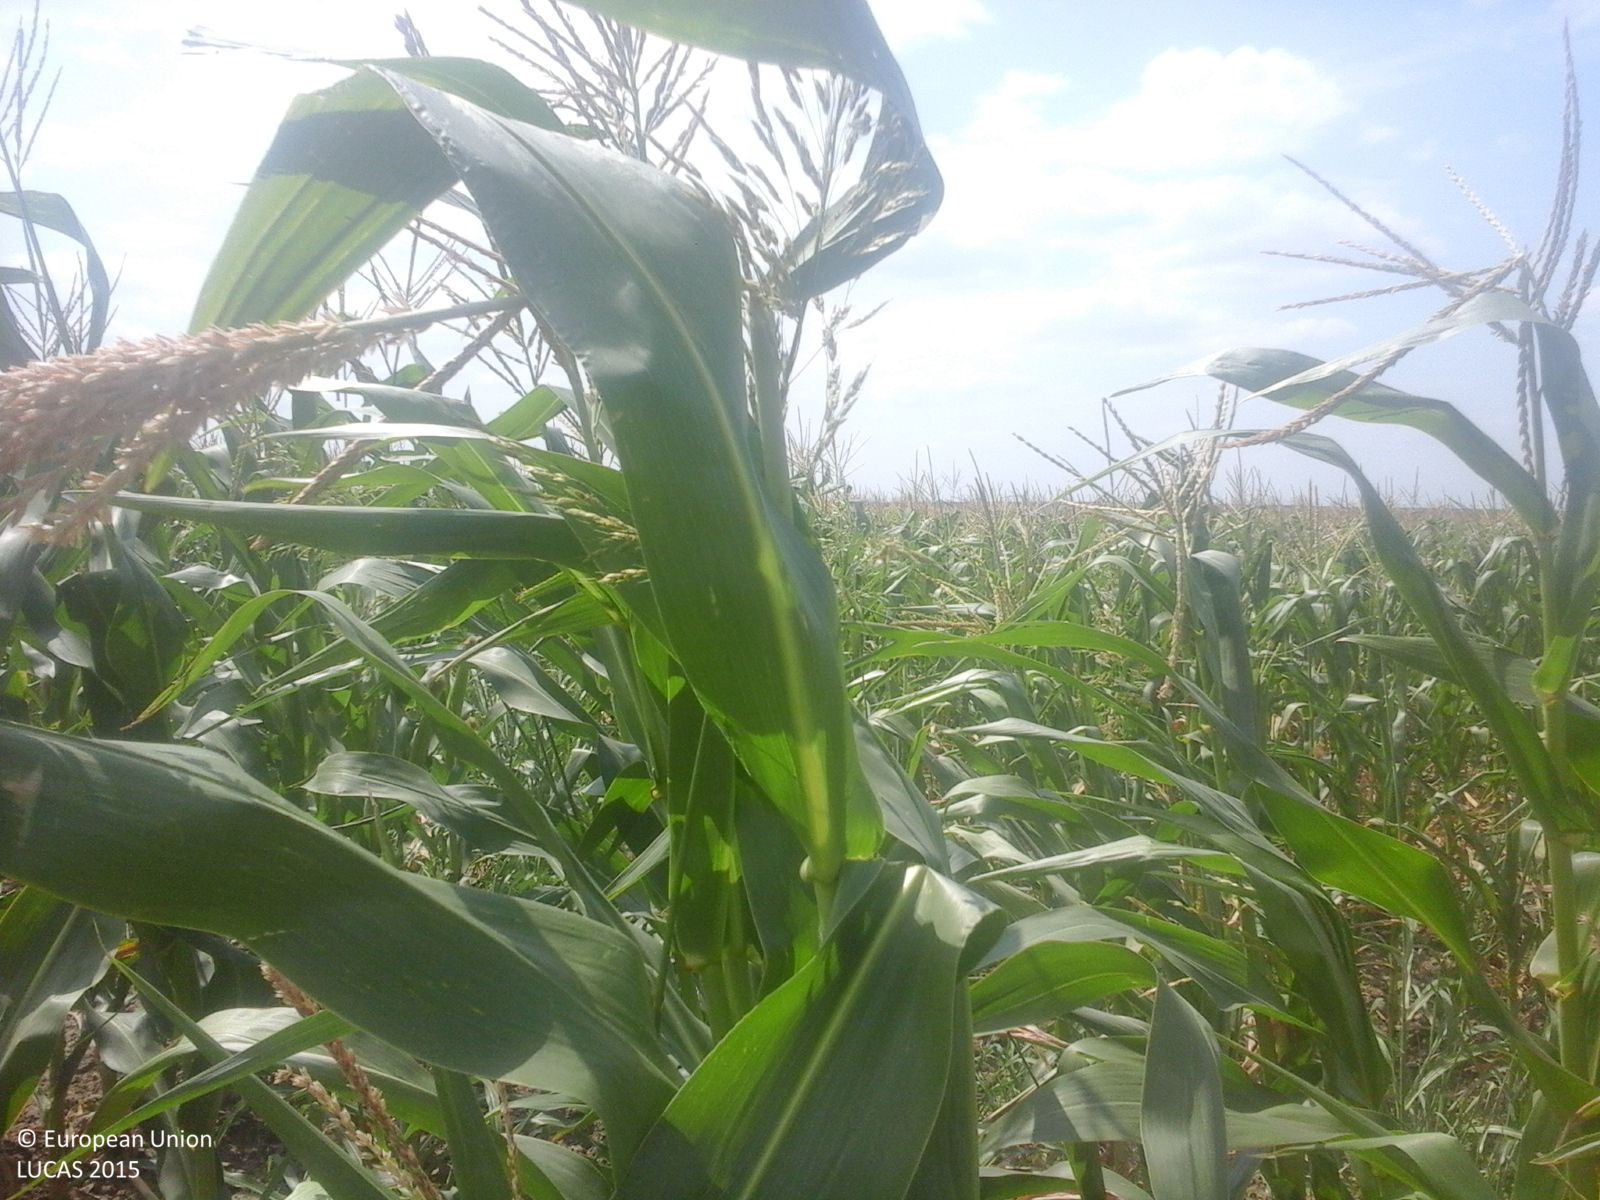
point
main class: Cropland
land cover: Maize
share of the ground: > 75 %
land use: Agriculture (excluding fallow land and kitchen gardens)
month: August
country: RO
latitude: 44.6900
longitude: 28.2495
